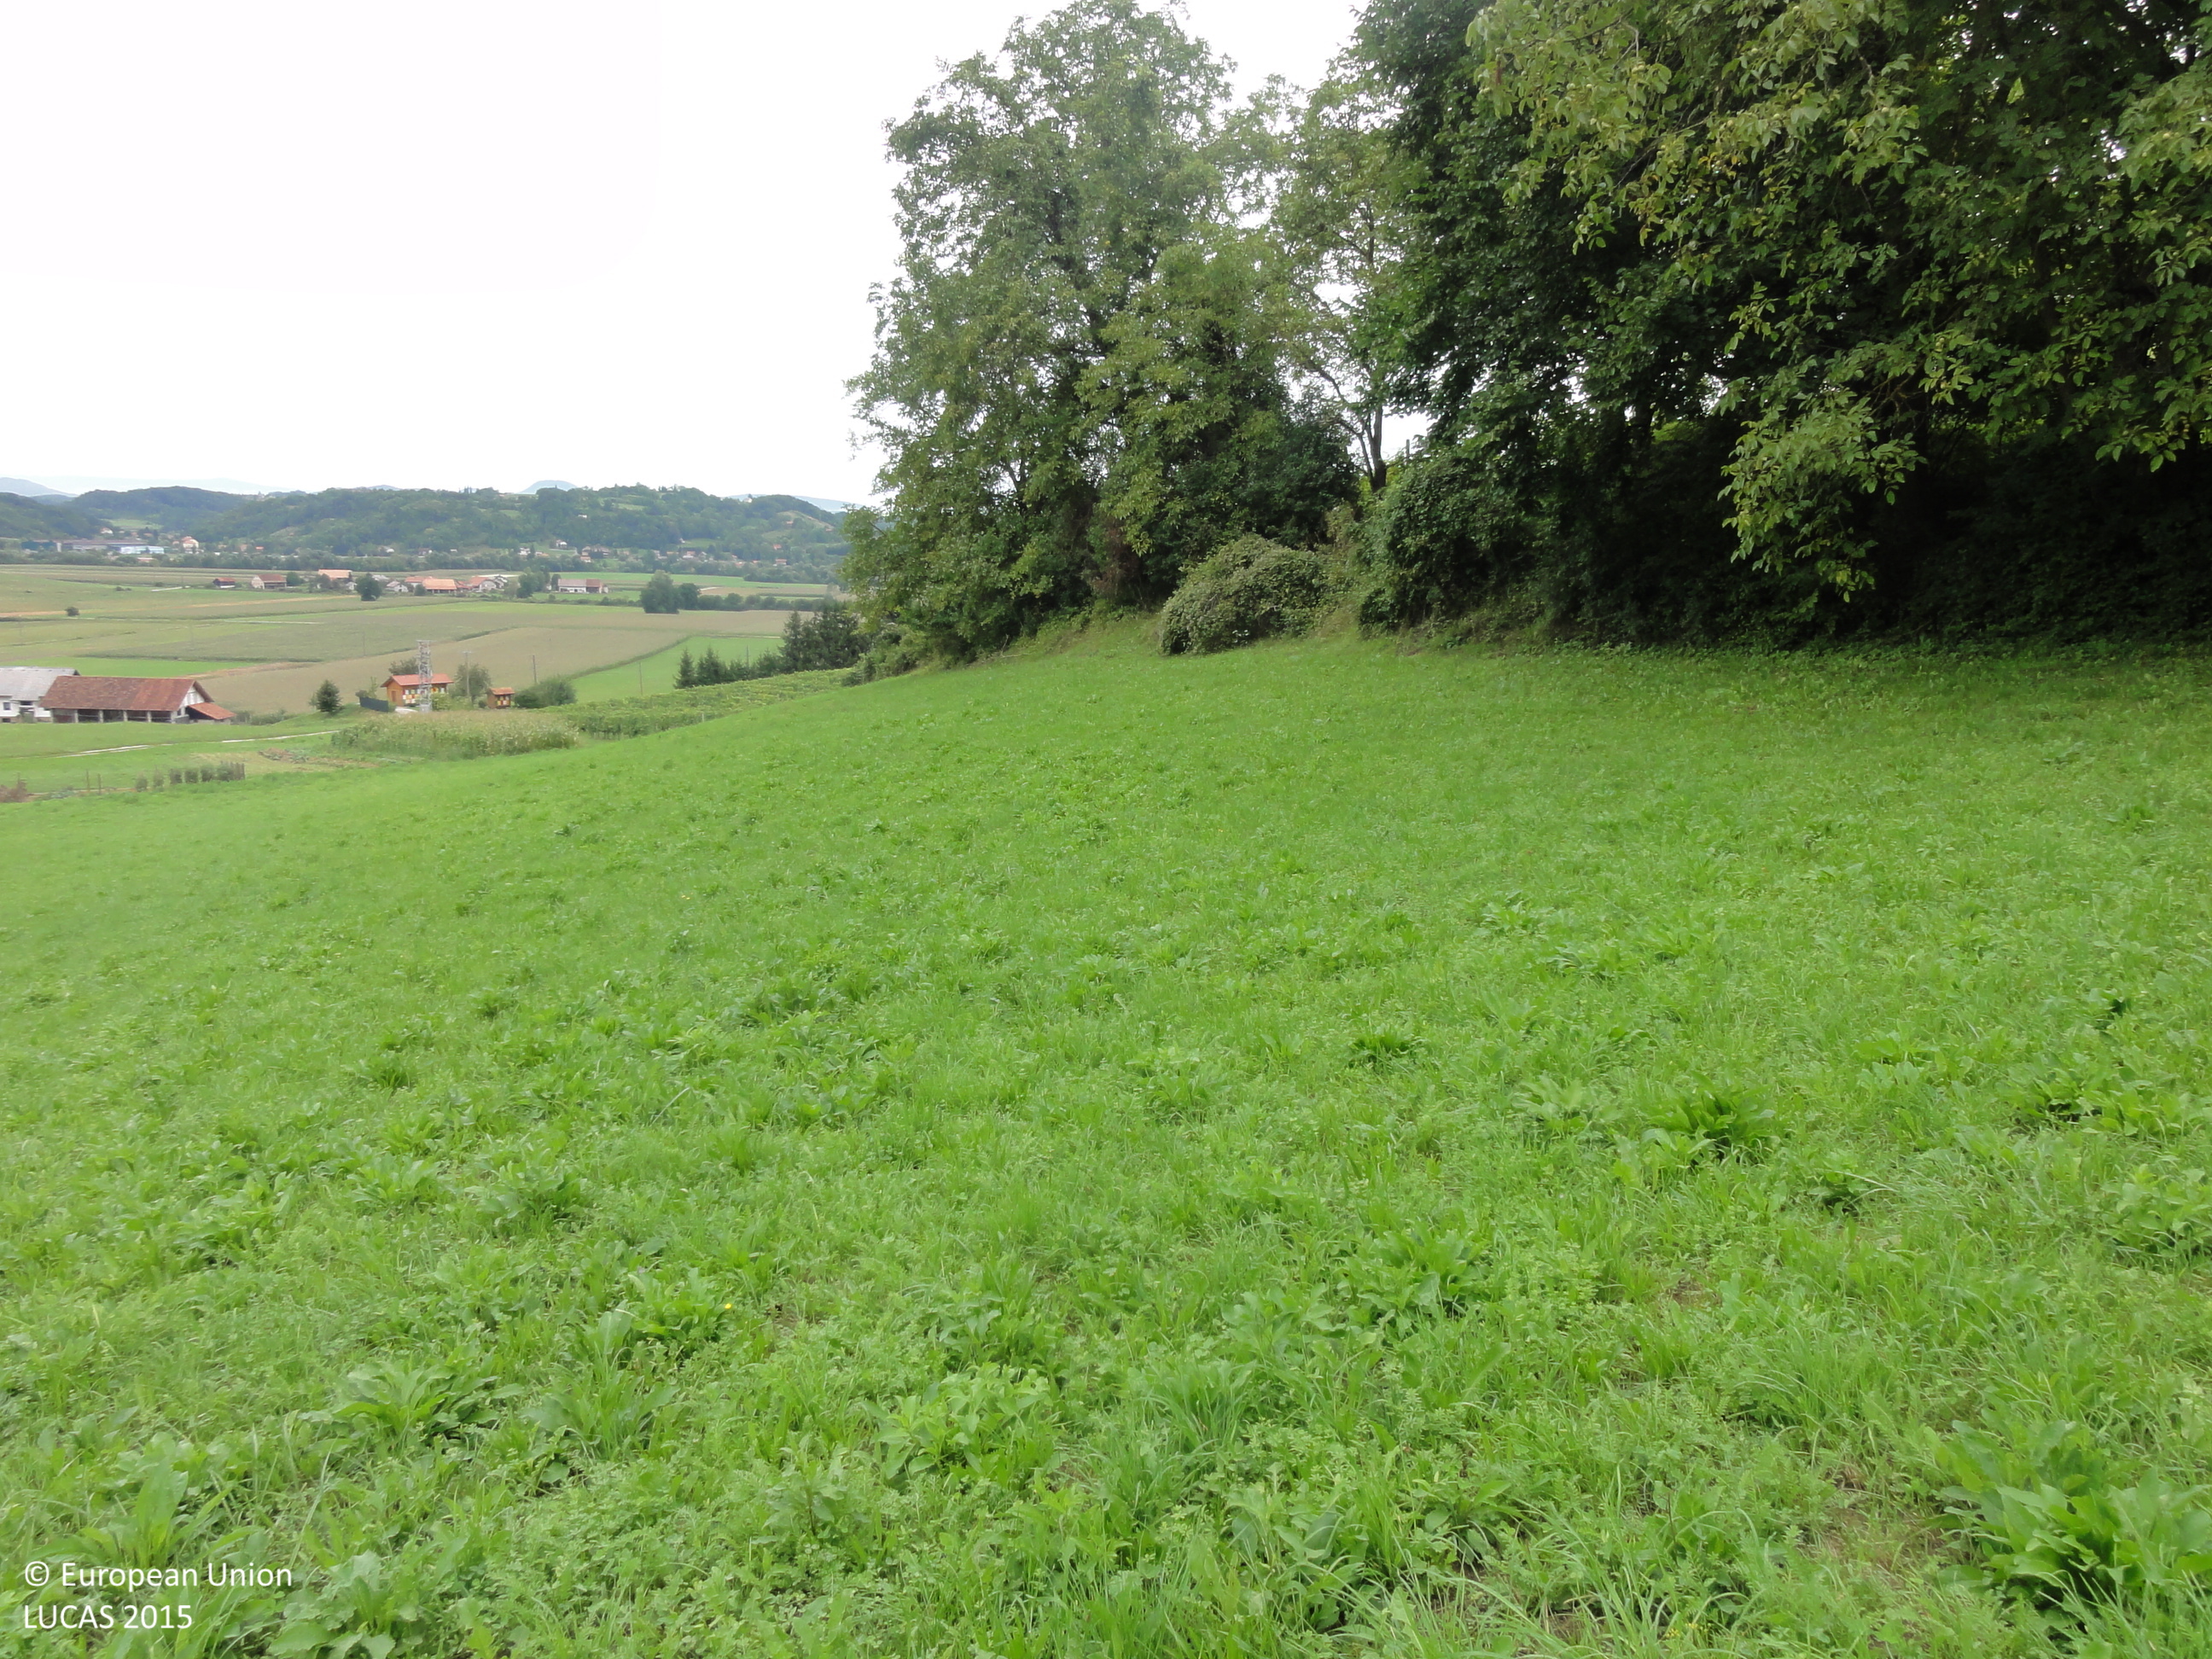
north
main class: Grassland
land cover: Grassland with sparse tree/shrub cover
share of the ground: > 75 %
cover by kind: herbaceous plants 90 %, coniferous forest trees 5 %, shrubs 5 %
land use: Agriculture (excluding fallow land and kitchen gardens)
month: August
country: SI
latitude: 46.0563
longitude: 15.6722
